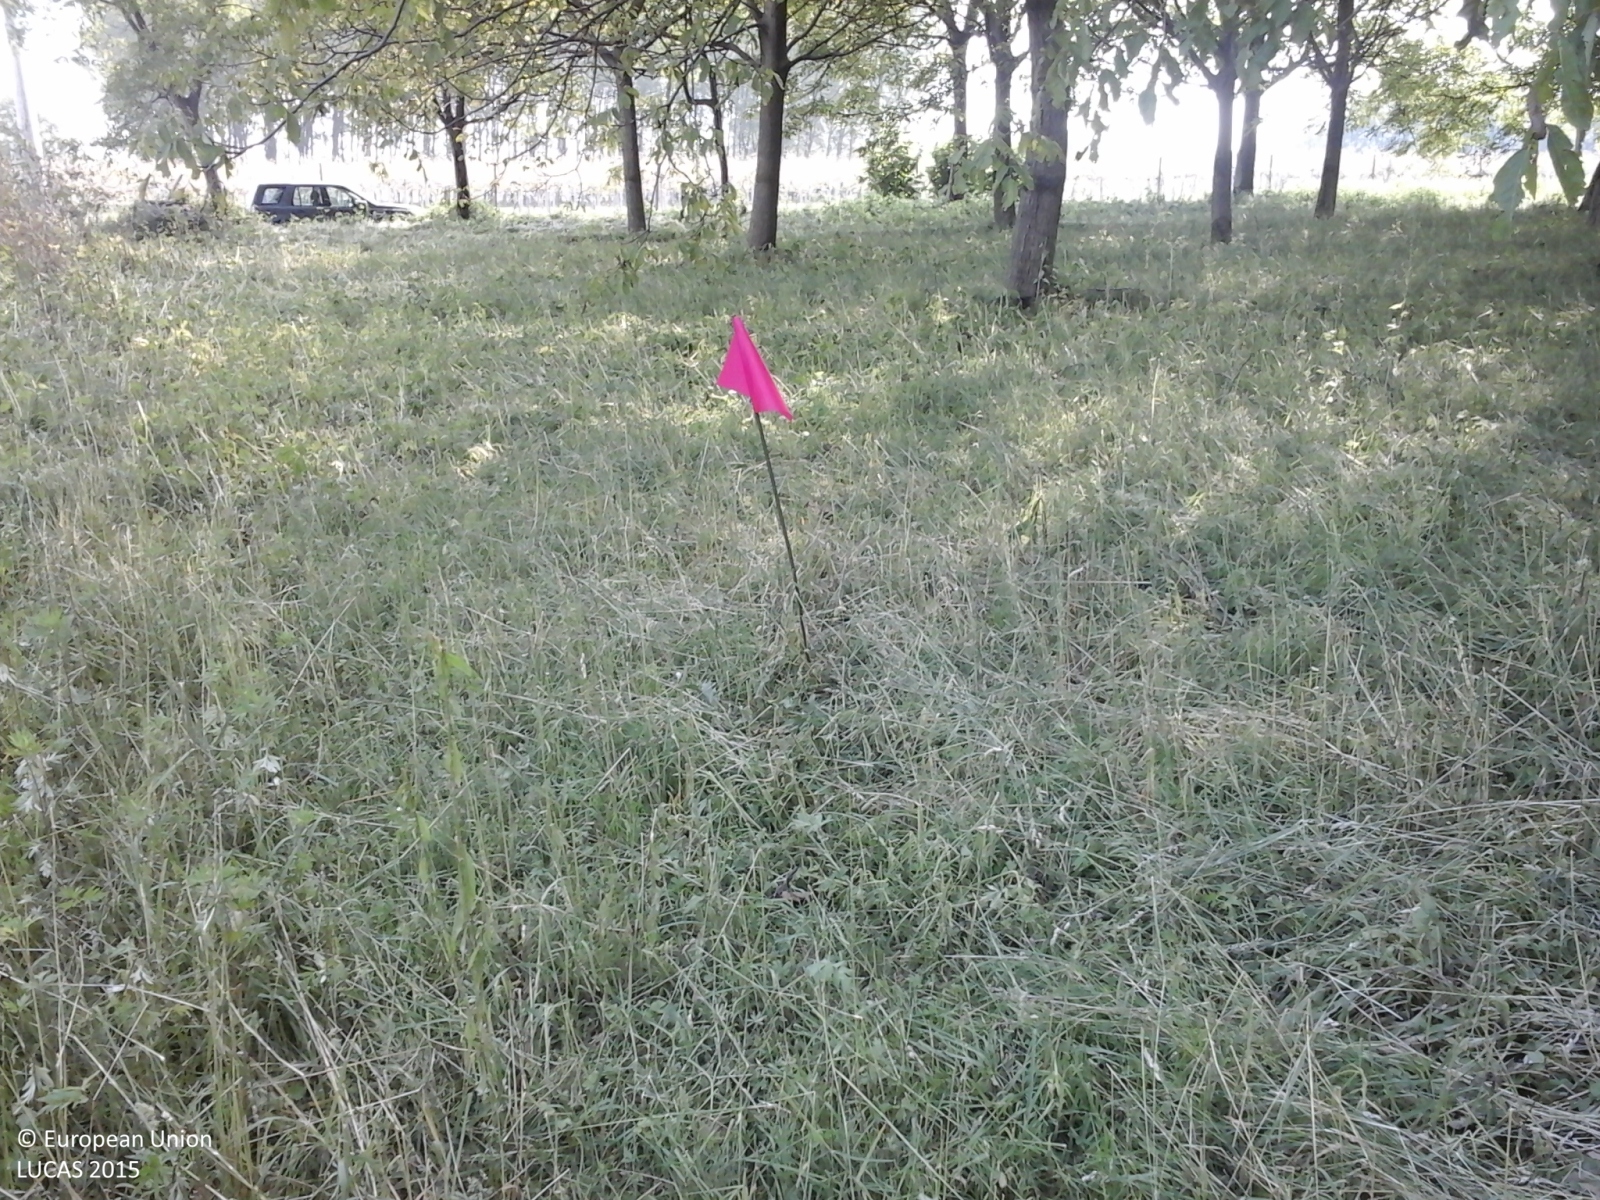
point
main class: Cropland
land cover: Nuts trees
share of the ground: > 75 %
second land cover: Grassland without tree/shrub cover
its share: > 75 %
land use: Agriculture (excluding fallow land and kitchen gardens)
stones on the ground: 10 - 25 %
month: May
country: IT
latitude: 44.8209
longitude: 7.3112
